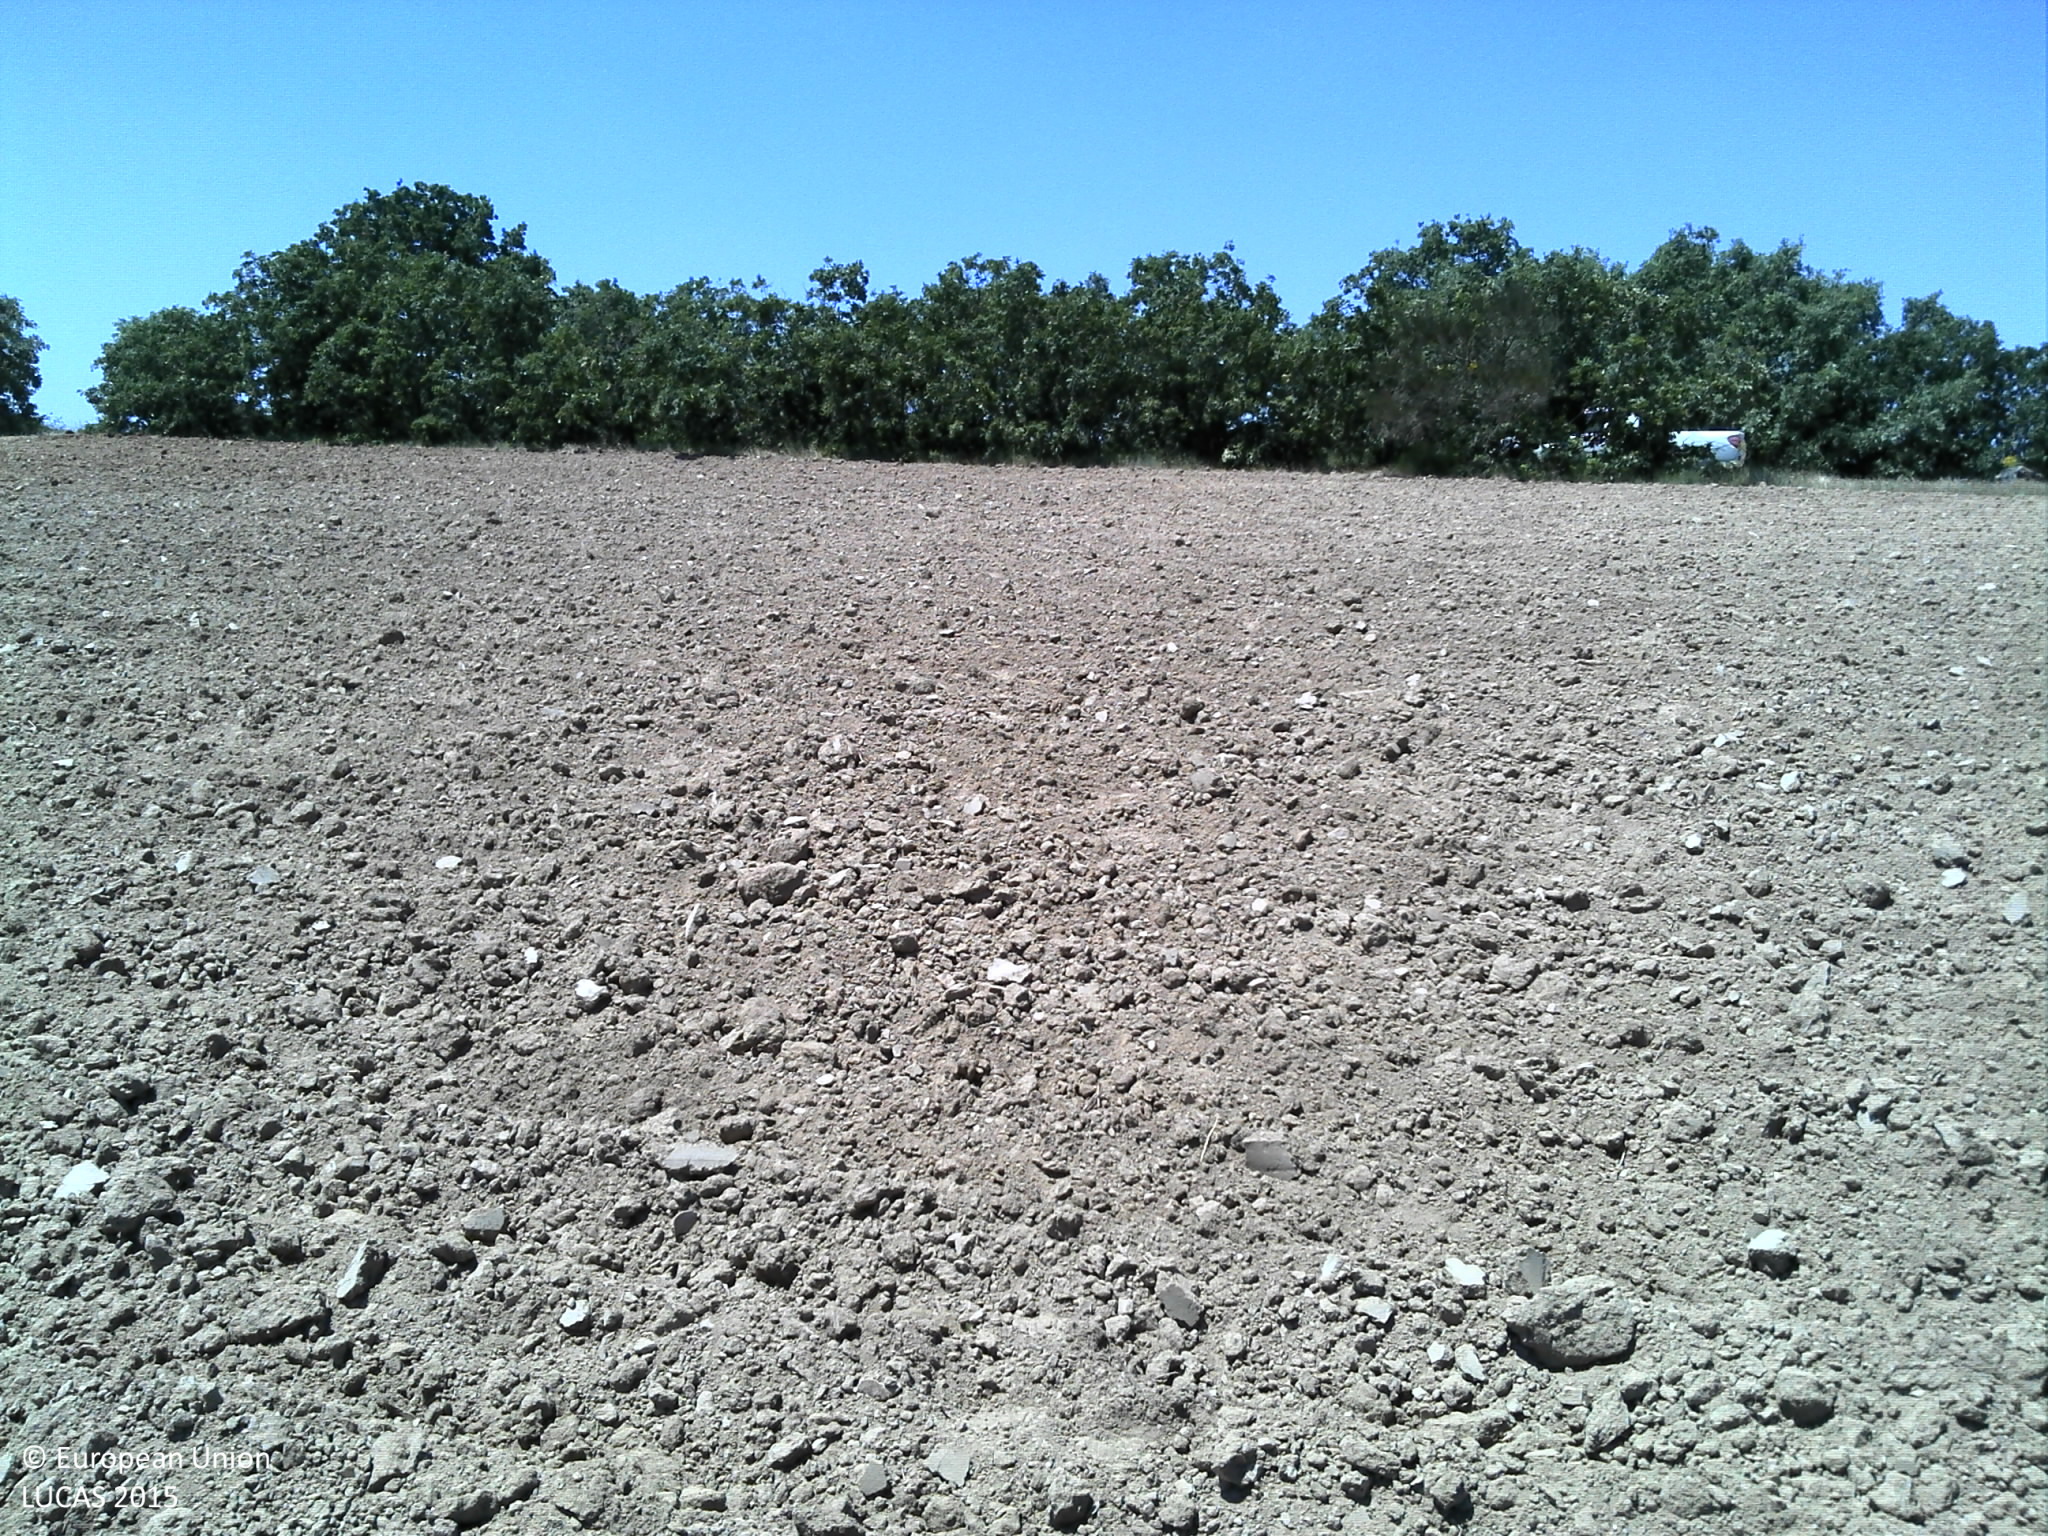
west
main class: Cropland
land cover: Oats
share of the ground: < 10 %
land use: Agriculture (excluding fallow land and kitchen gardens)
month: May
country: PT
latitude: 41.5371
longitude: -6.3411
